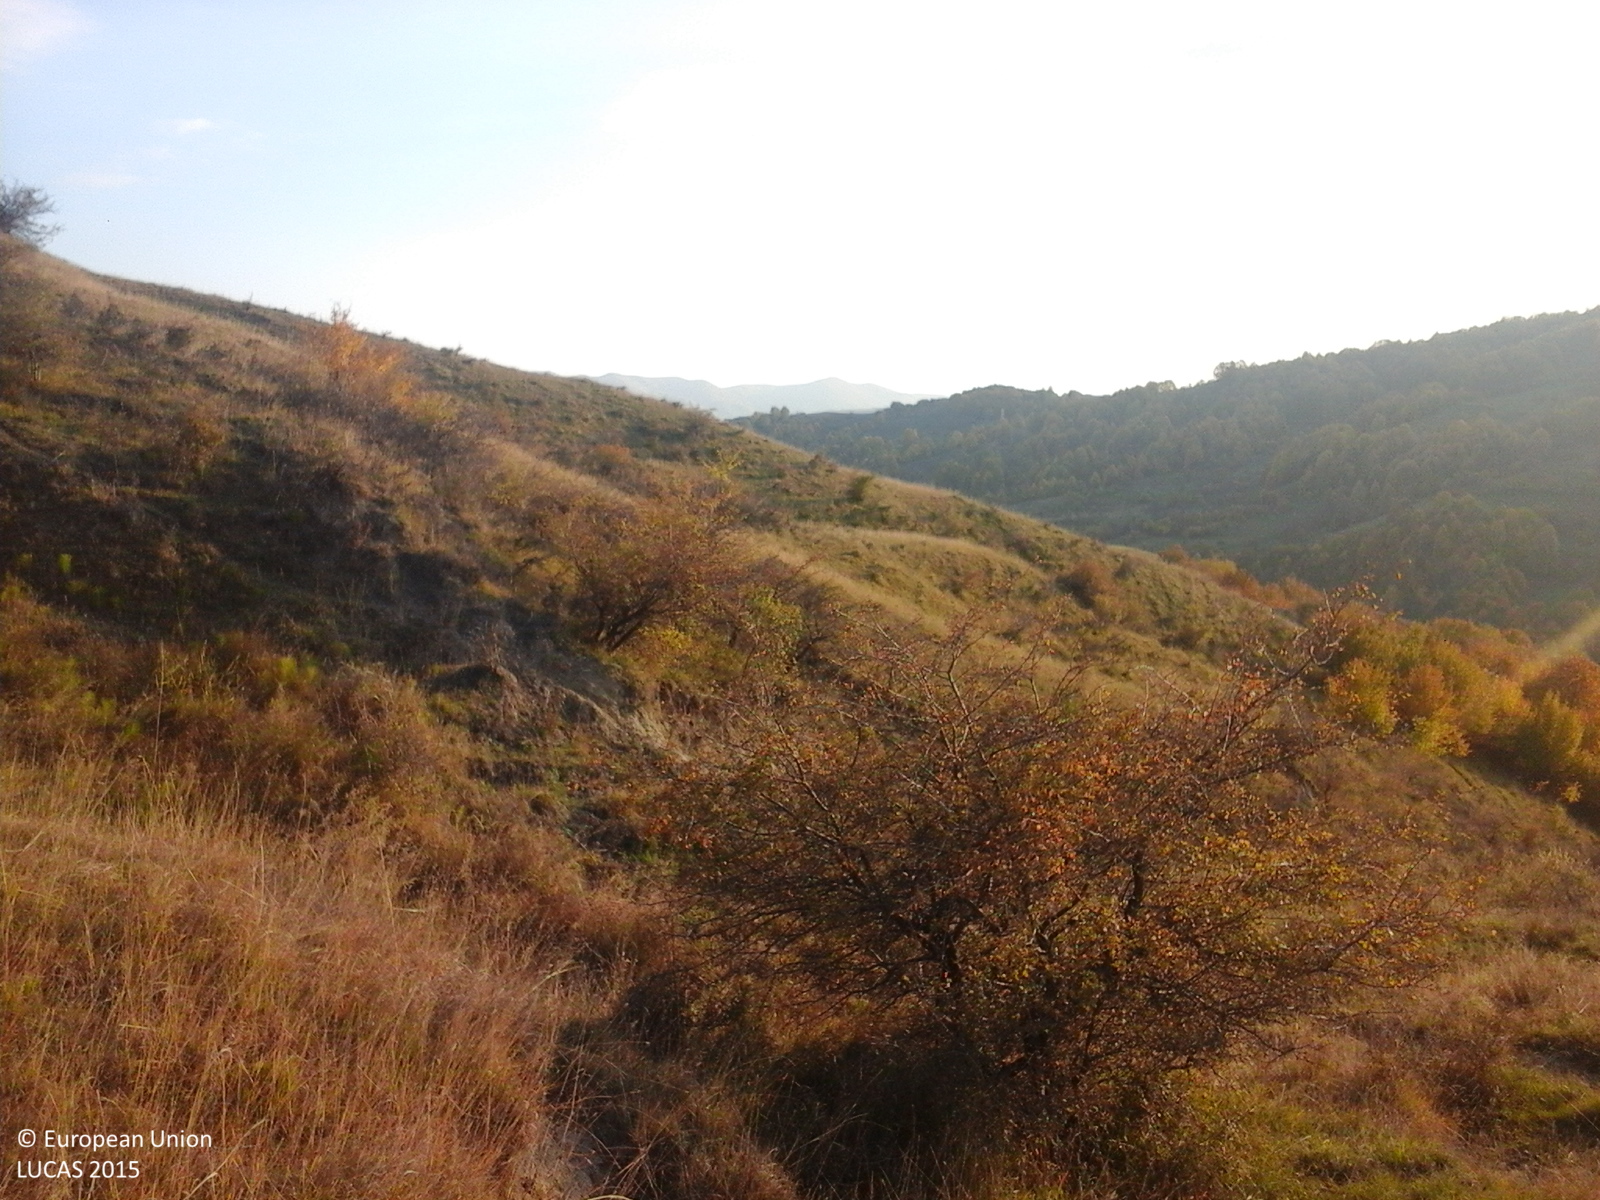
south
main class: Grassland
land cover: Grassland without tree/shrub cover
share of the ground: > 75 %
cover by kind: herbaceous plants 100 %
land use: Agriculture (excluding fallow land and kitchen gardens)
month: October
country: RO
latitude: 45.4319
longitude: 26.5777
